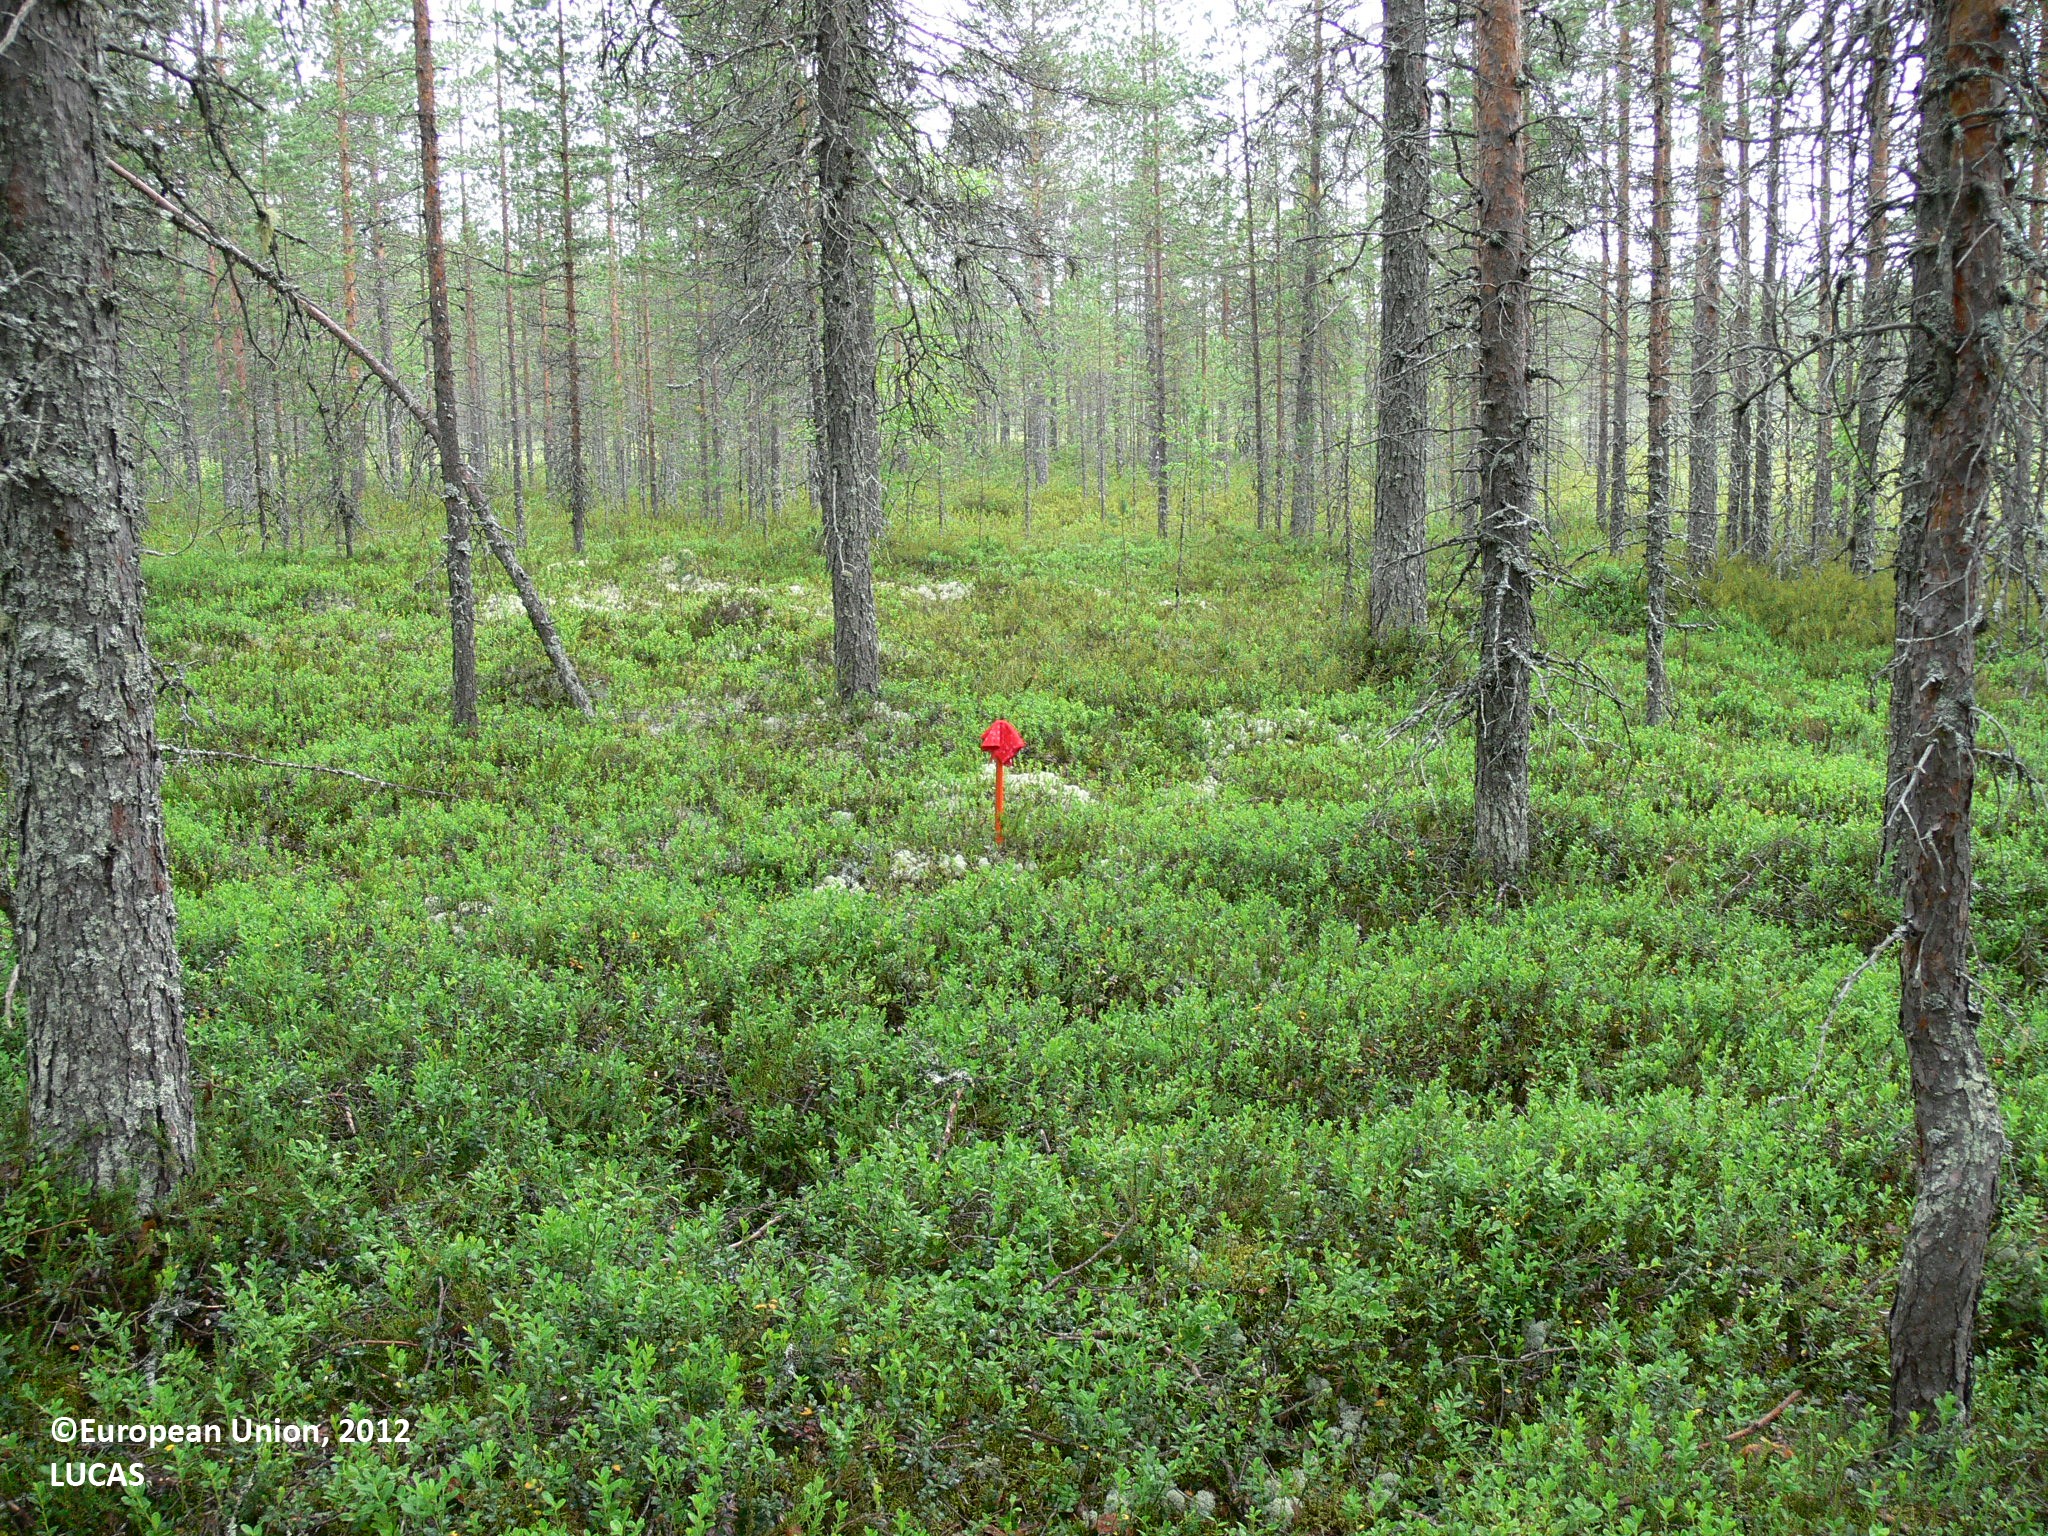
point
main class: Woodland
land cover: Pine dominated coniferous woodland
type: boreal forest
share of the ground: 50 - 75 %
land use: Forestry
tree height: > 5 m
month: July
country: FI
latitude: 63.1959
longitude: 30.8214
